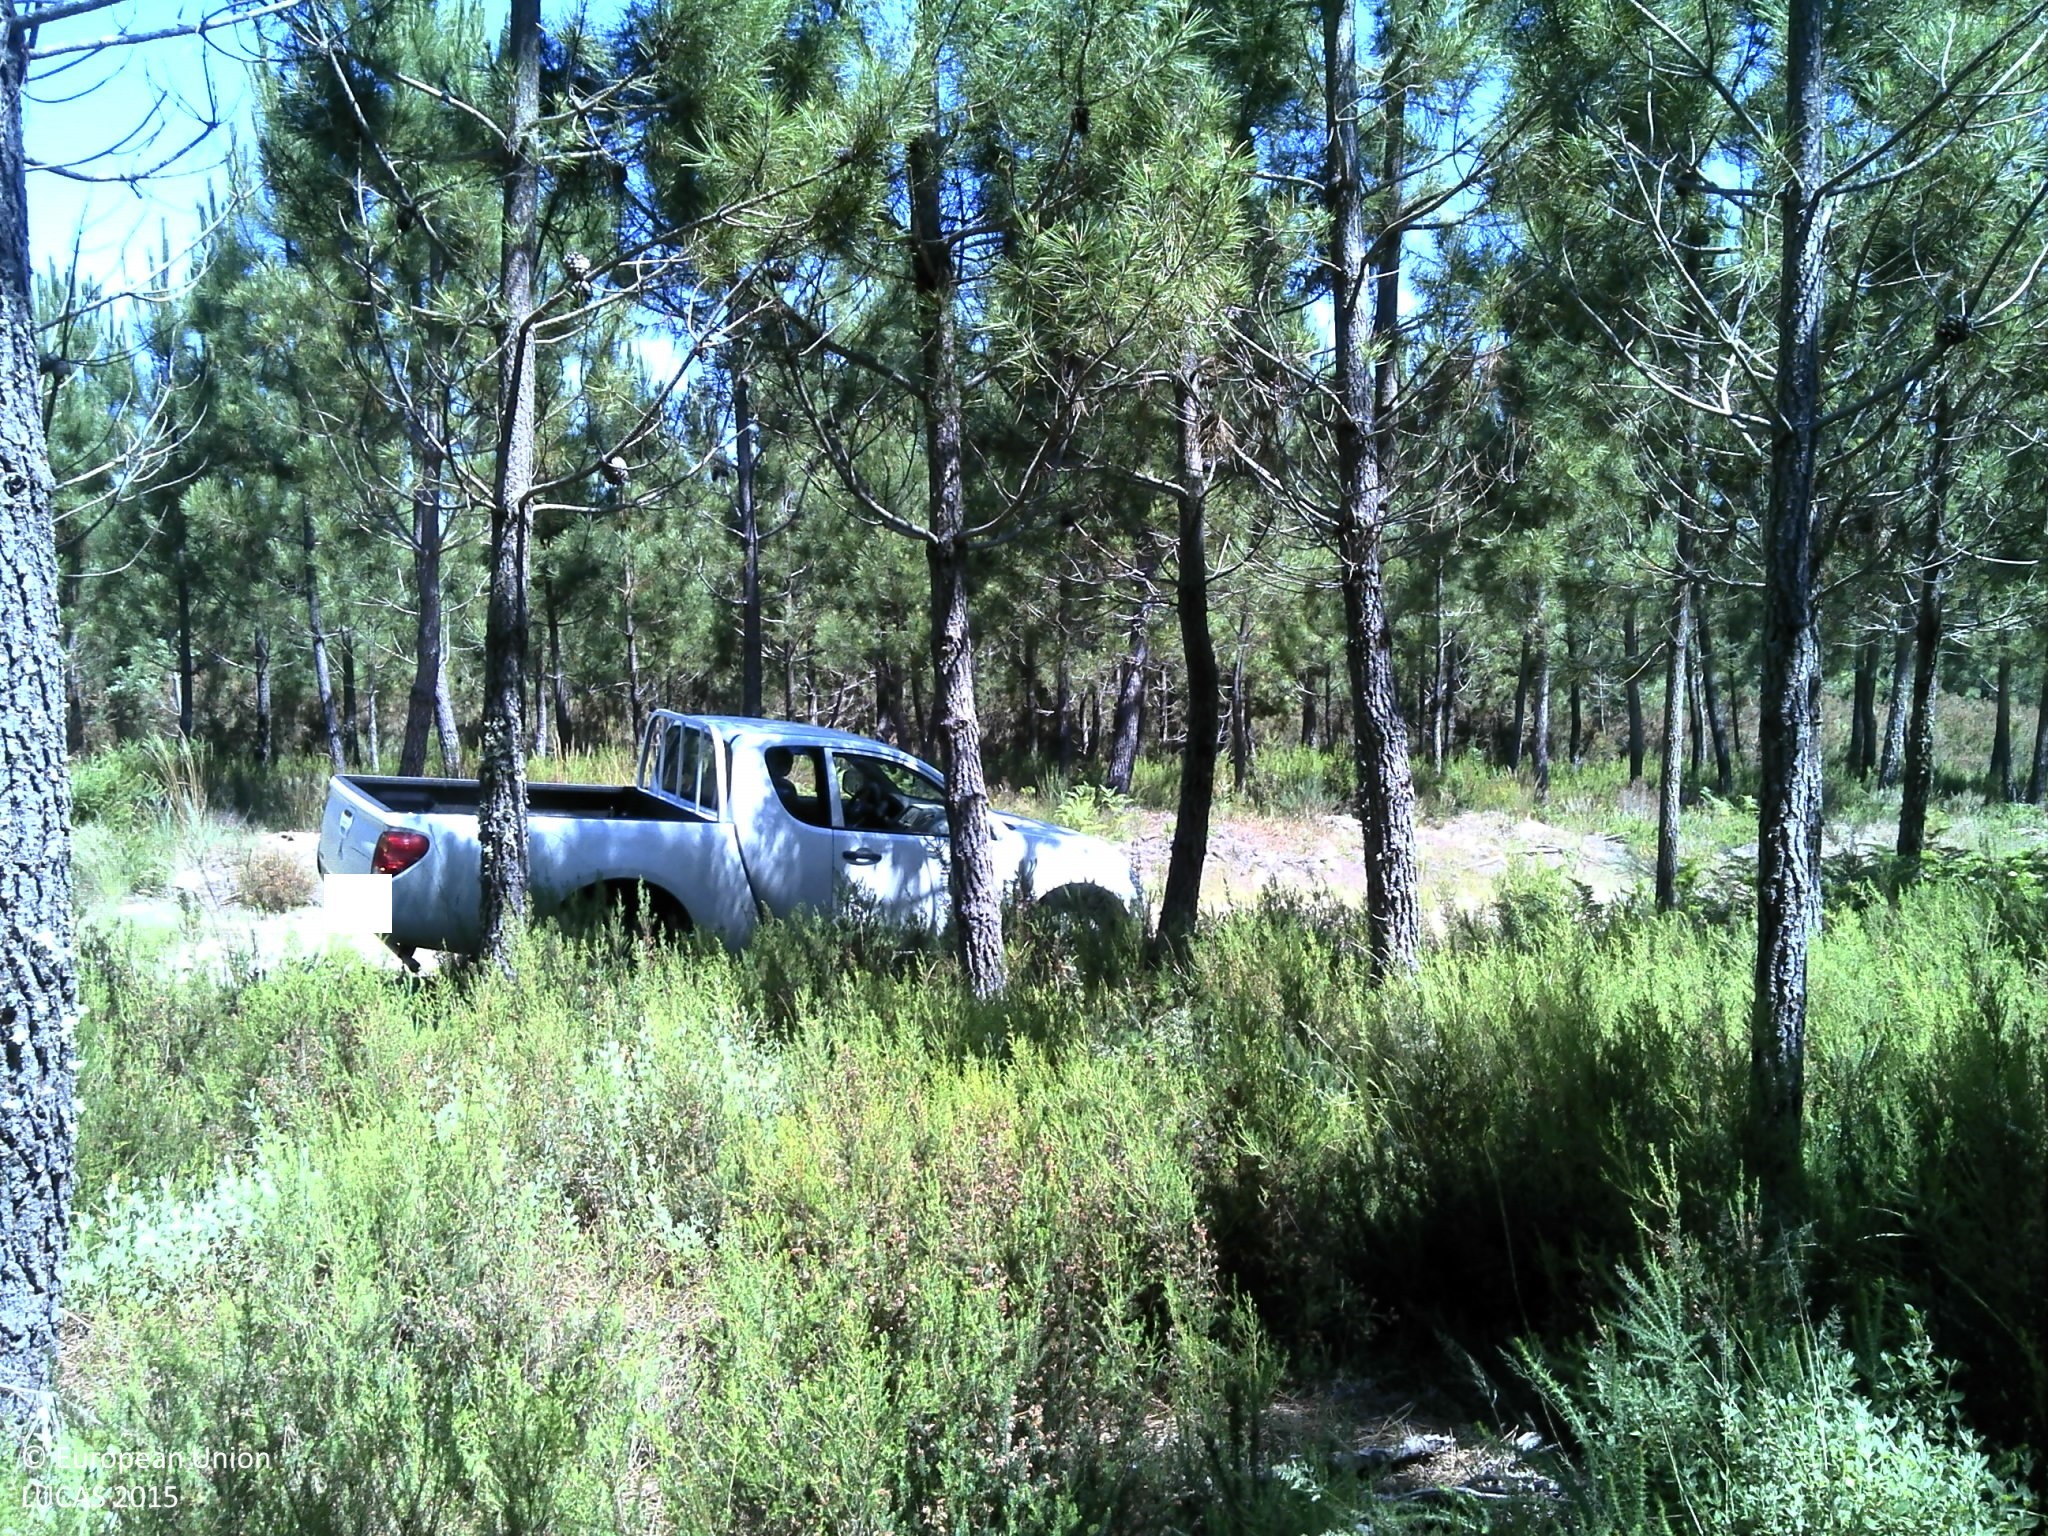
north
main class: Woodland
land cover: Pine dominated coniferous woodland
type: coniferous forest of the mediterranean region
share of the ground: > 75 %
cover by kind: coniferous forest trees 75 %, shrubs 20 %
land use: Forestry
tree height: > 5 m
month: June
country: PT
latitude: 40.9299
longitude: -7.6143
